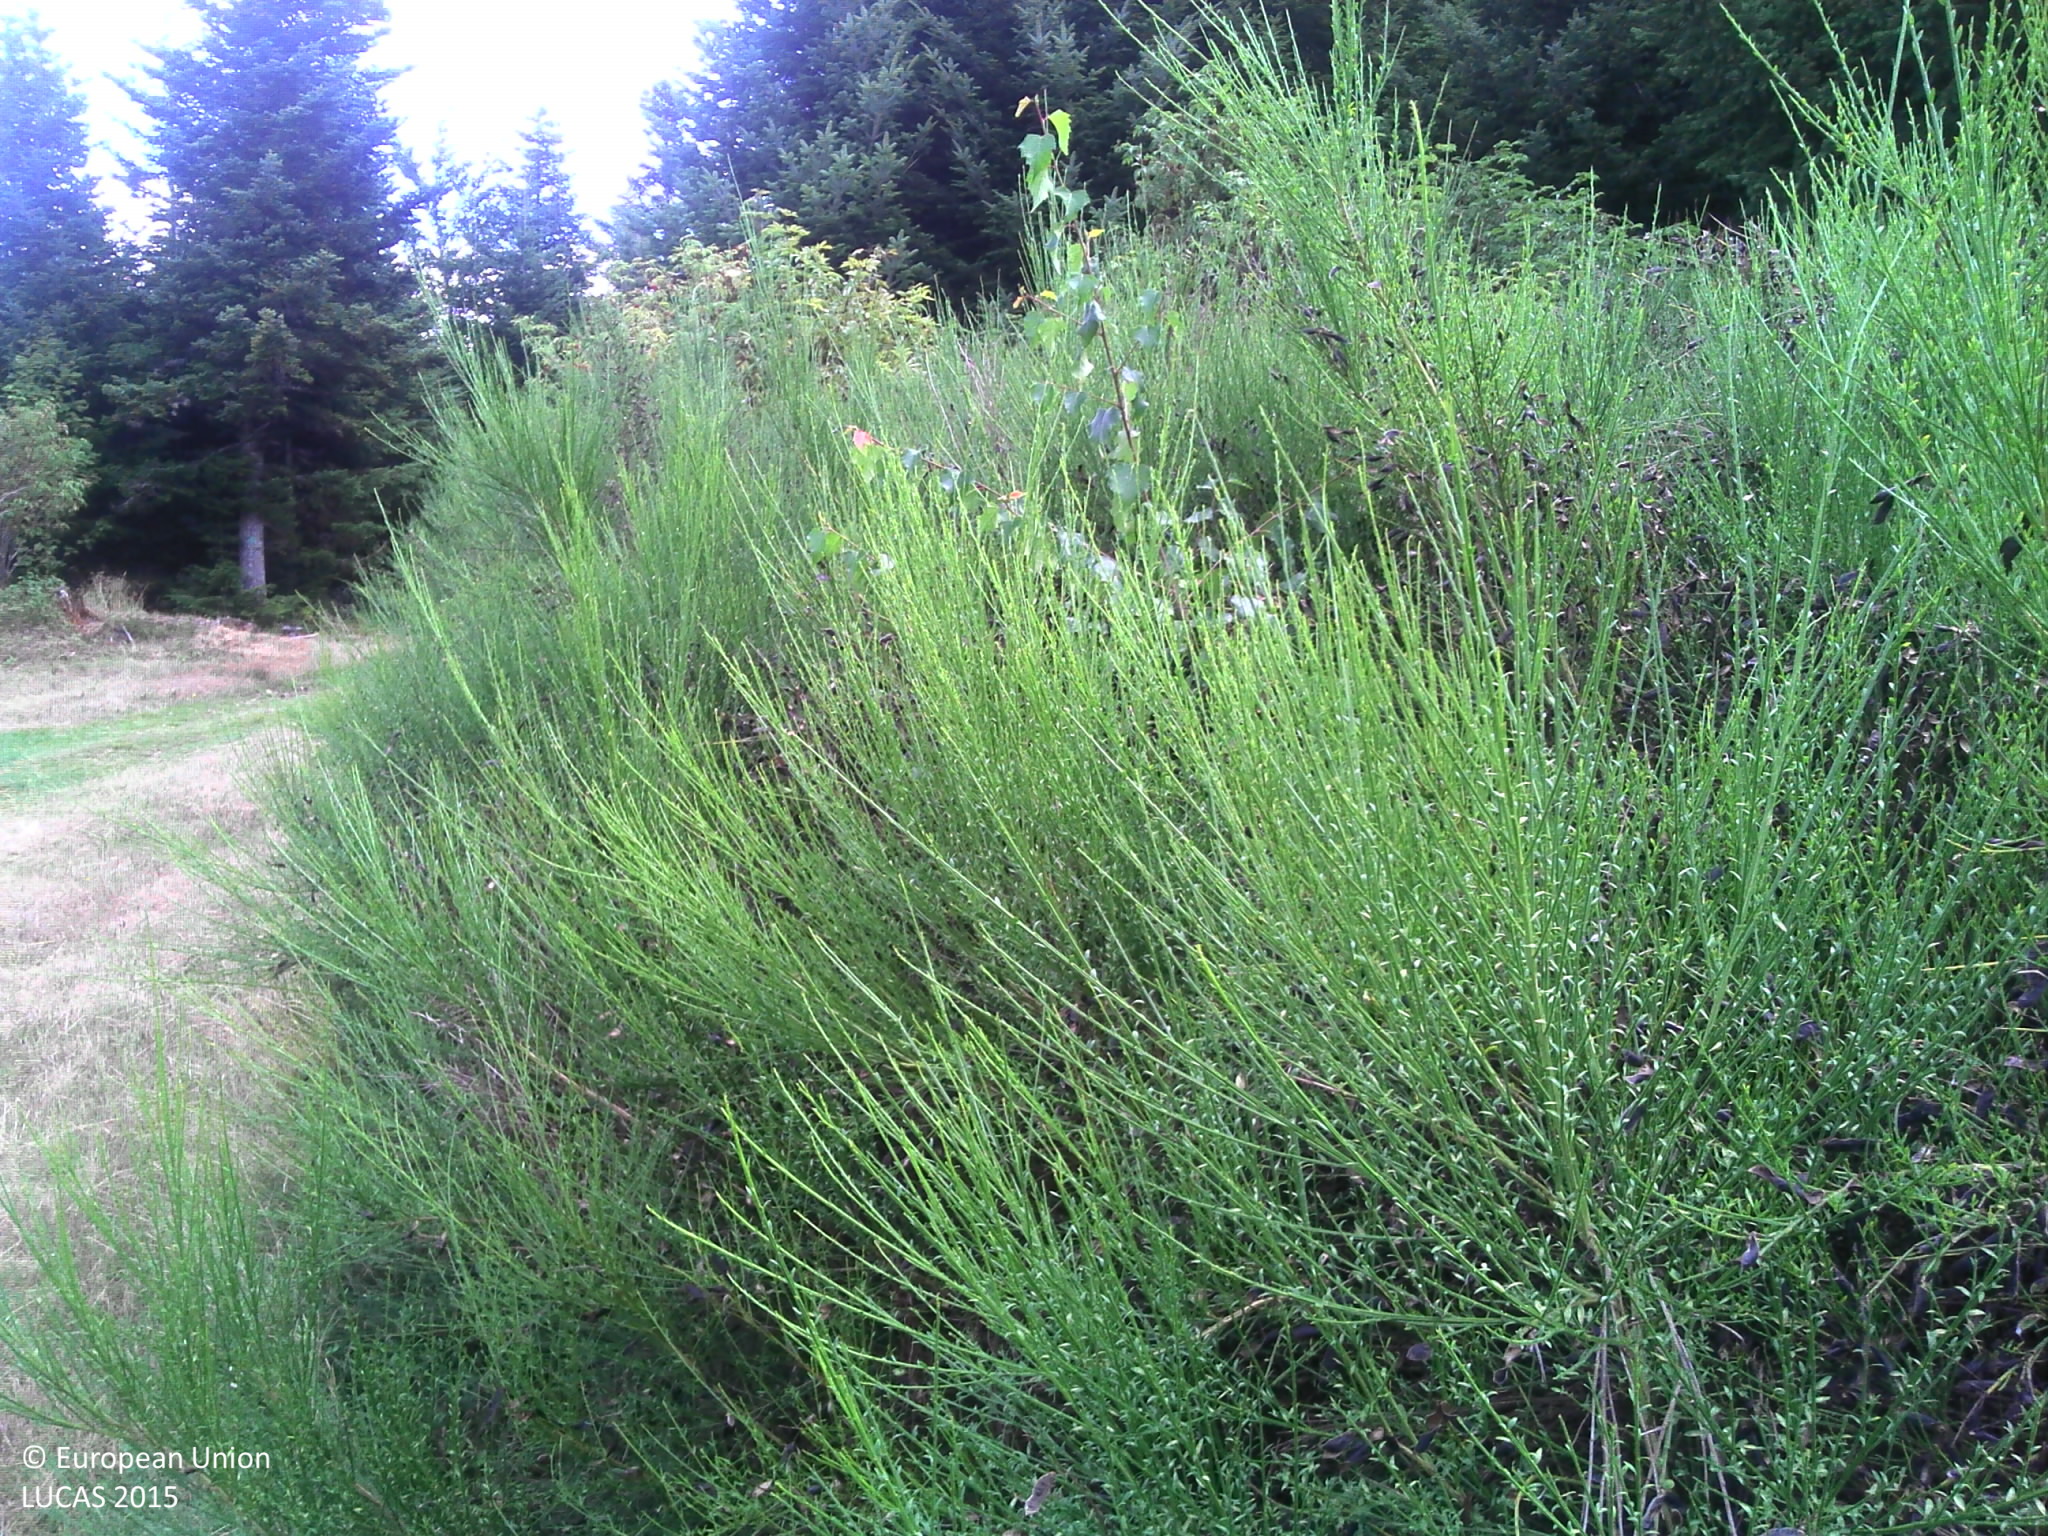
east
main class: Shrubland
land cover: Shrubland without tree cover
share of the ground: > 75 %
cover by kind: shrubs 95 %, unconsolidated bare surface 5 %
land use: Semi-natural and natural areas not in use
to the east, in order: Shrubland without tree cover; Spruce dominated coniferous woodland; Shrubland with sparse tree cover; Spruce dominated coniferous woodland
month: August
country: FR
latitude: 45.1096
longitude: 4.5268
